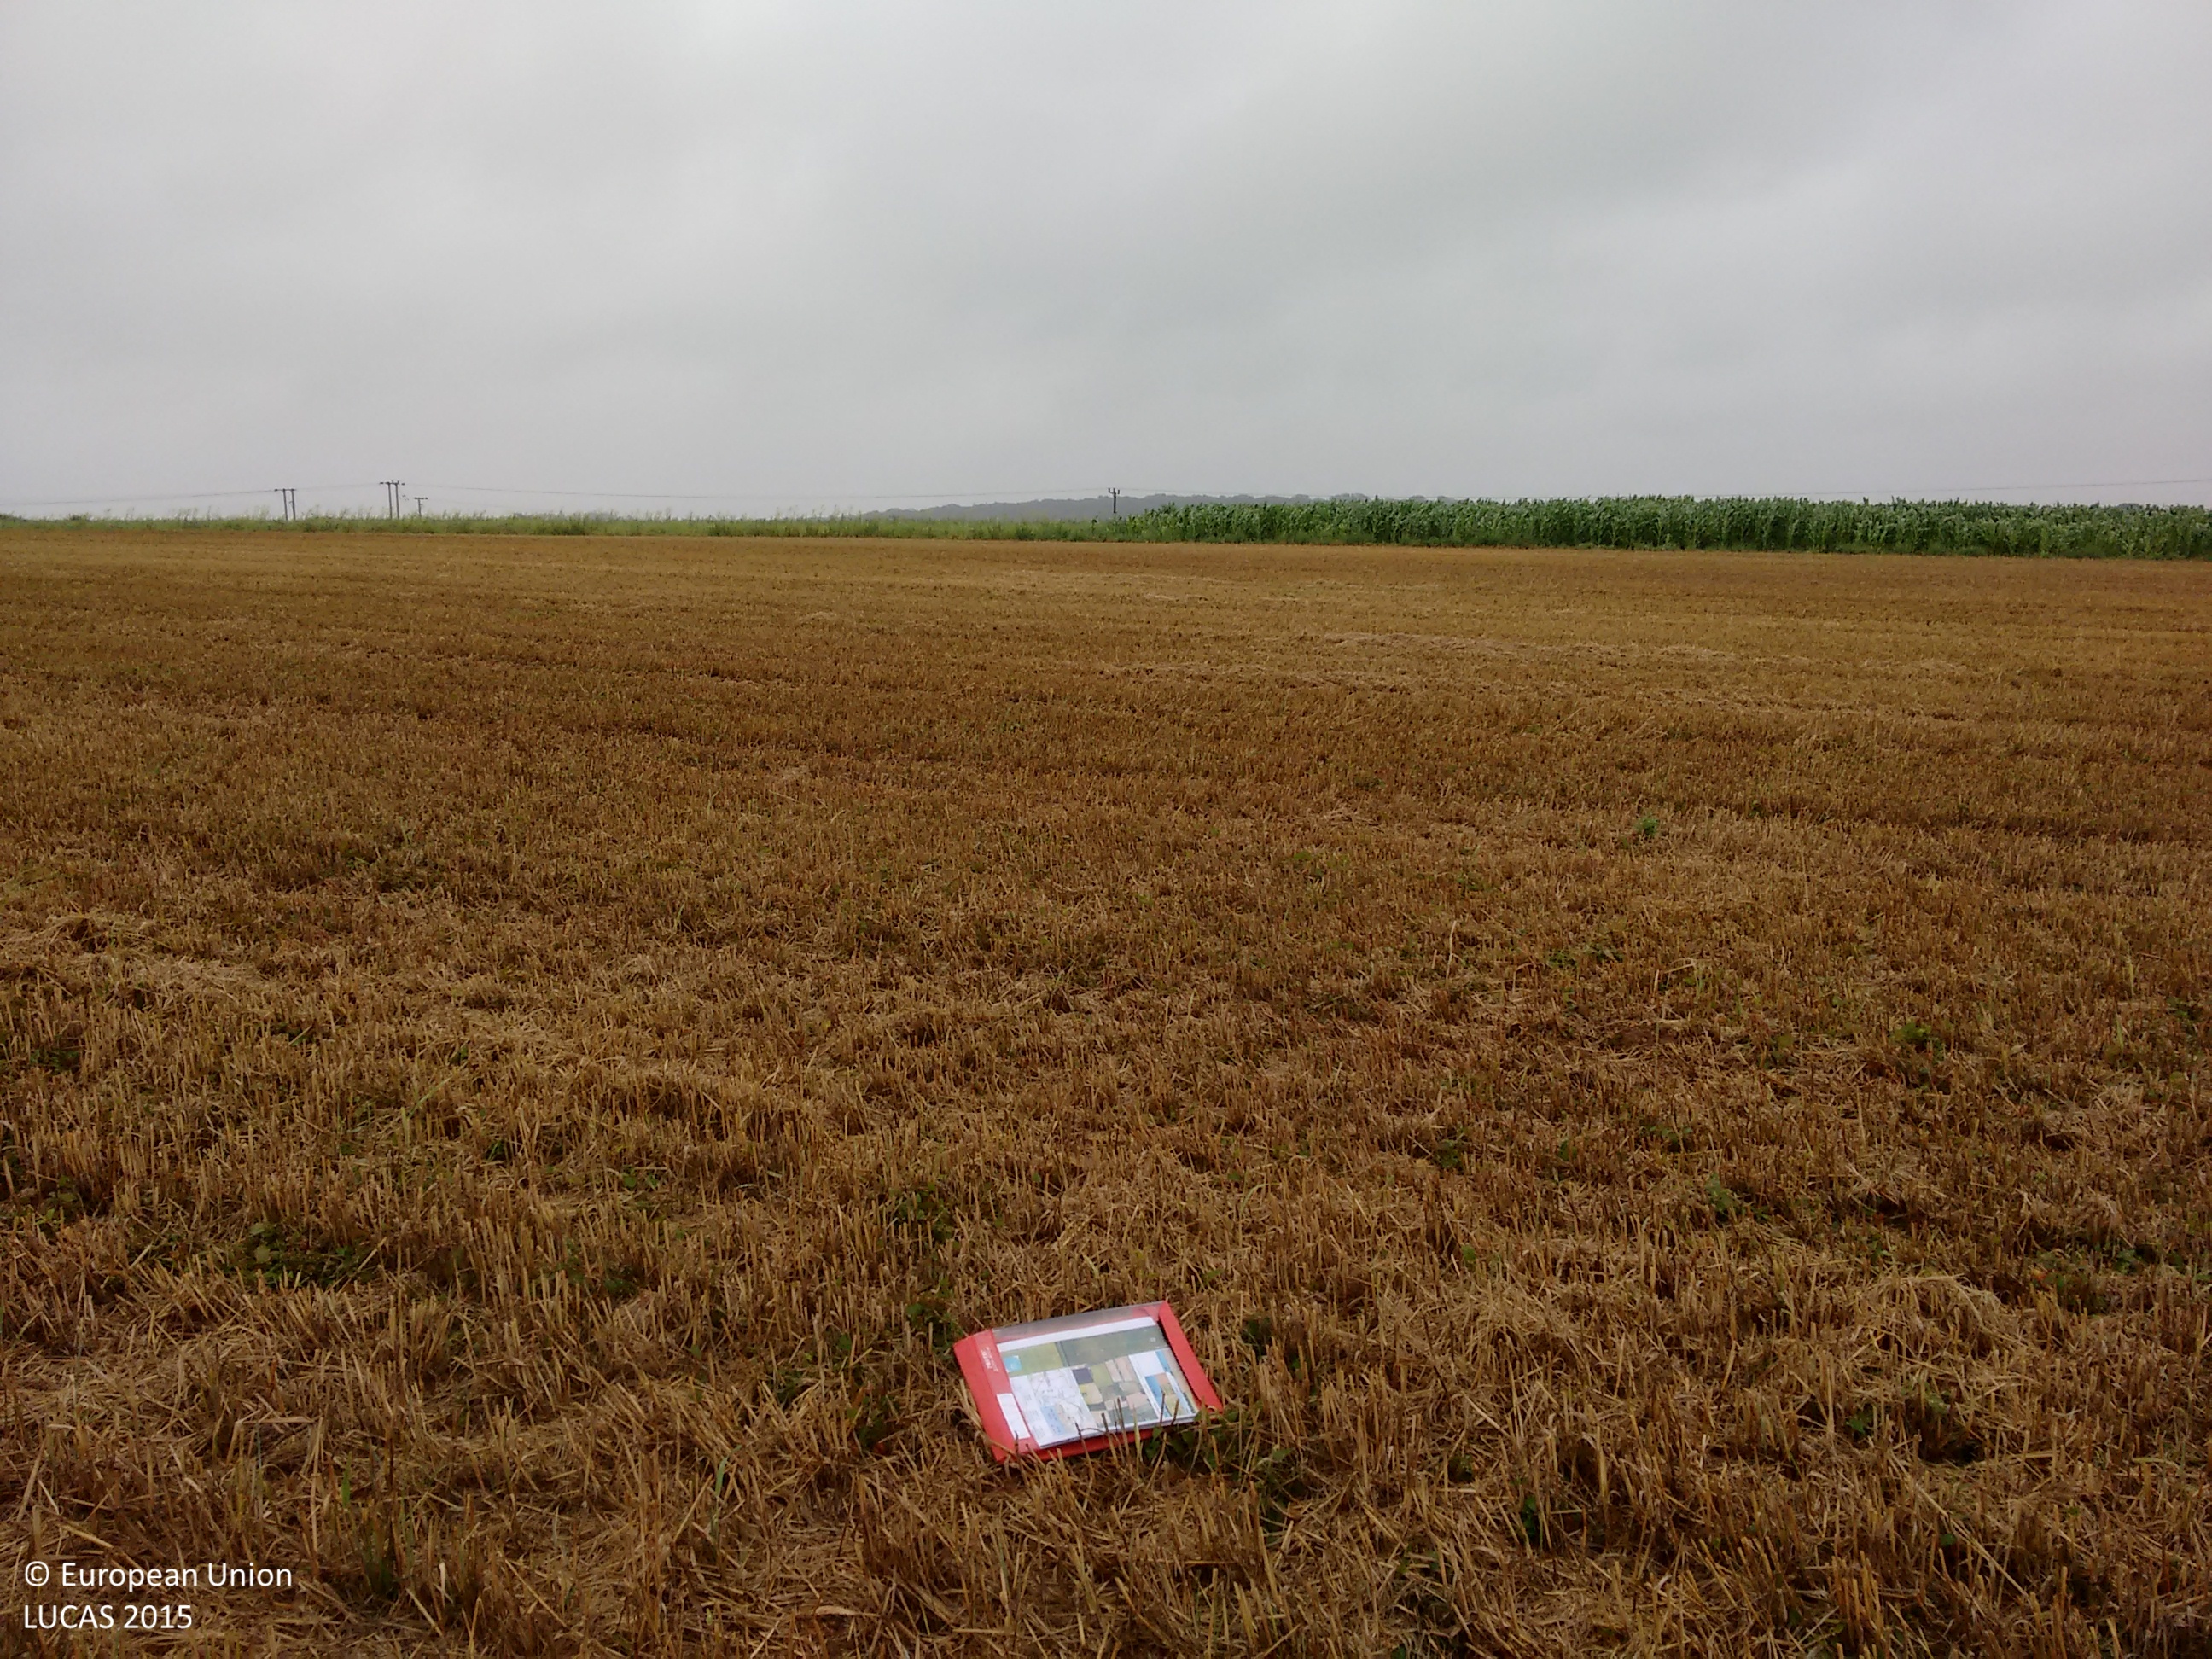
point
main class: Cropland
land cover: Common wheat
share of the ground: > 75 %
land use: Agriculture (excluding fallow land and kitchen gardens)
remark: Harvested field
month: August
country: GB
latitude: 52.9220
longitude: 0.7684
